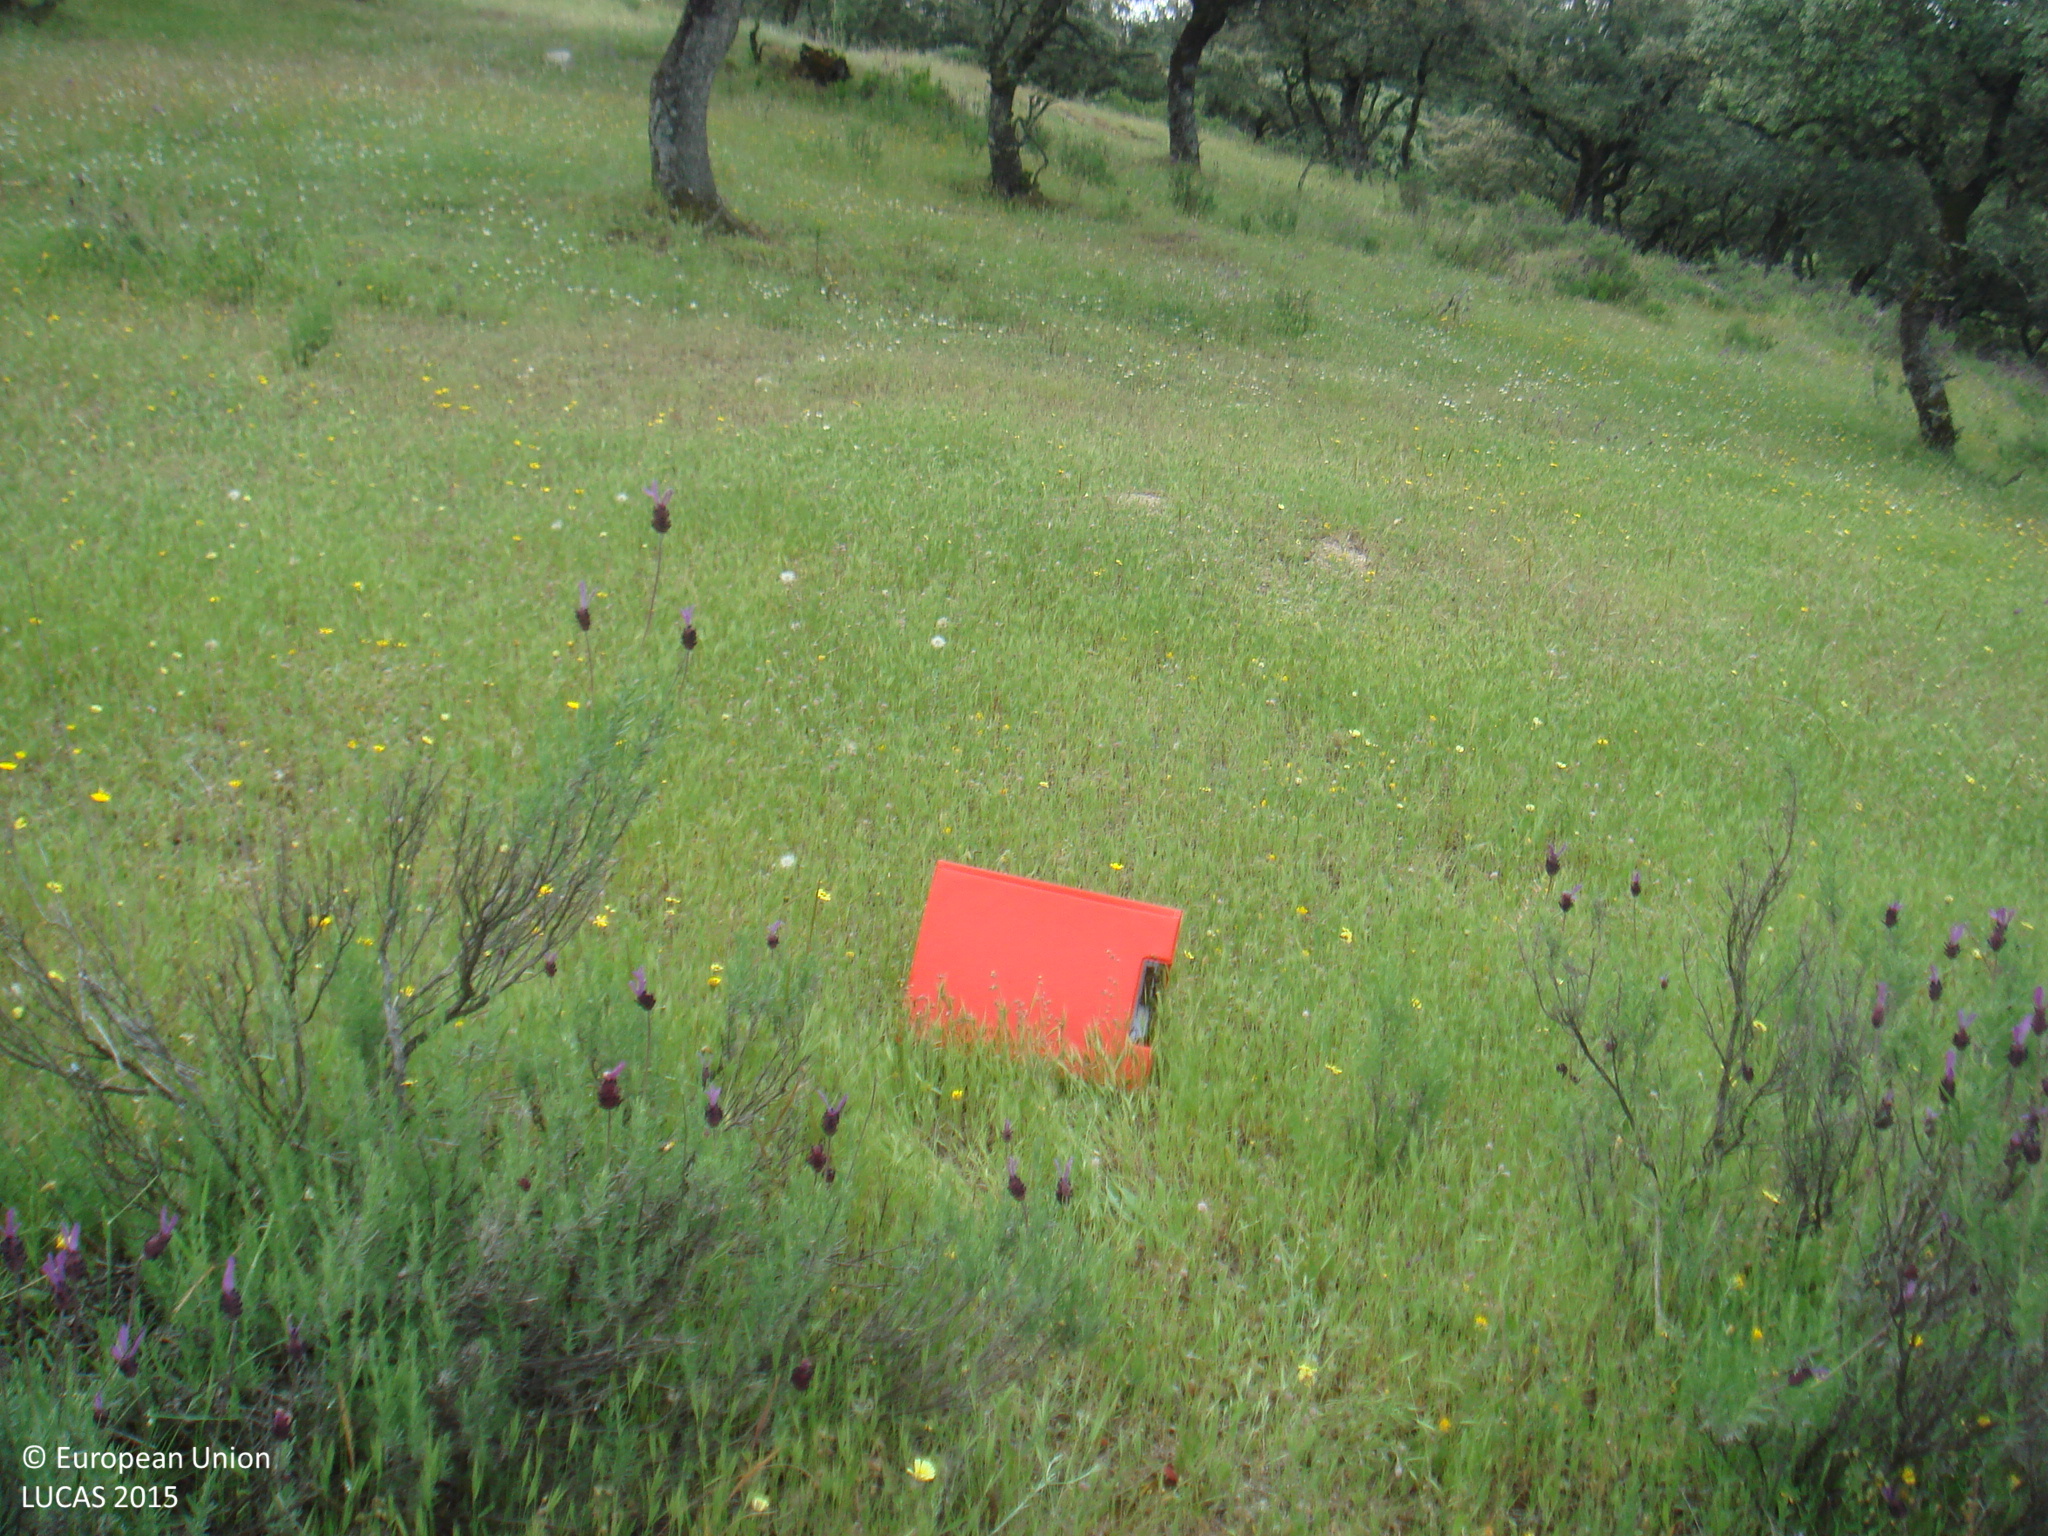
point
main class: Woodland
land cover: Broadleaved woodland
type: broadleaved evergreen forest
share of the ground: > 75 %
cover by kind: broadleaved forest trees 40 %, herbaceous plants 30 %, shrubs 20 %, coniferous forest trees 10 %
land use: Forestry
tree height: > 5 m
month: April
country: ES
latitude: 38.1730
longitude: -4.3852
